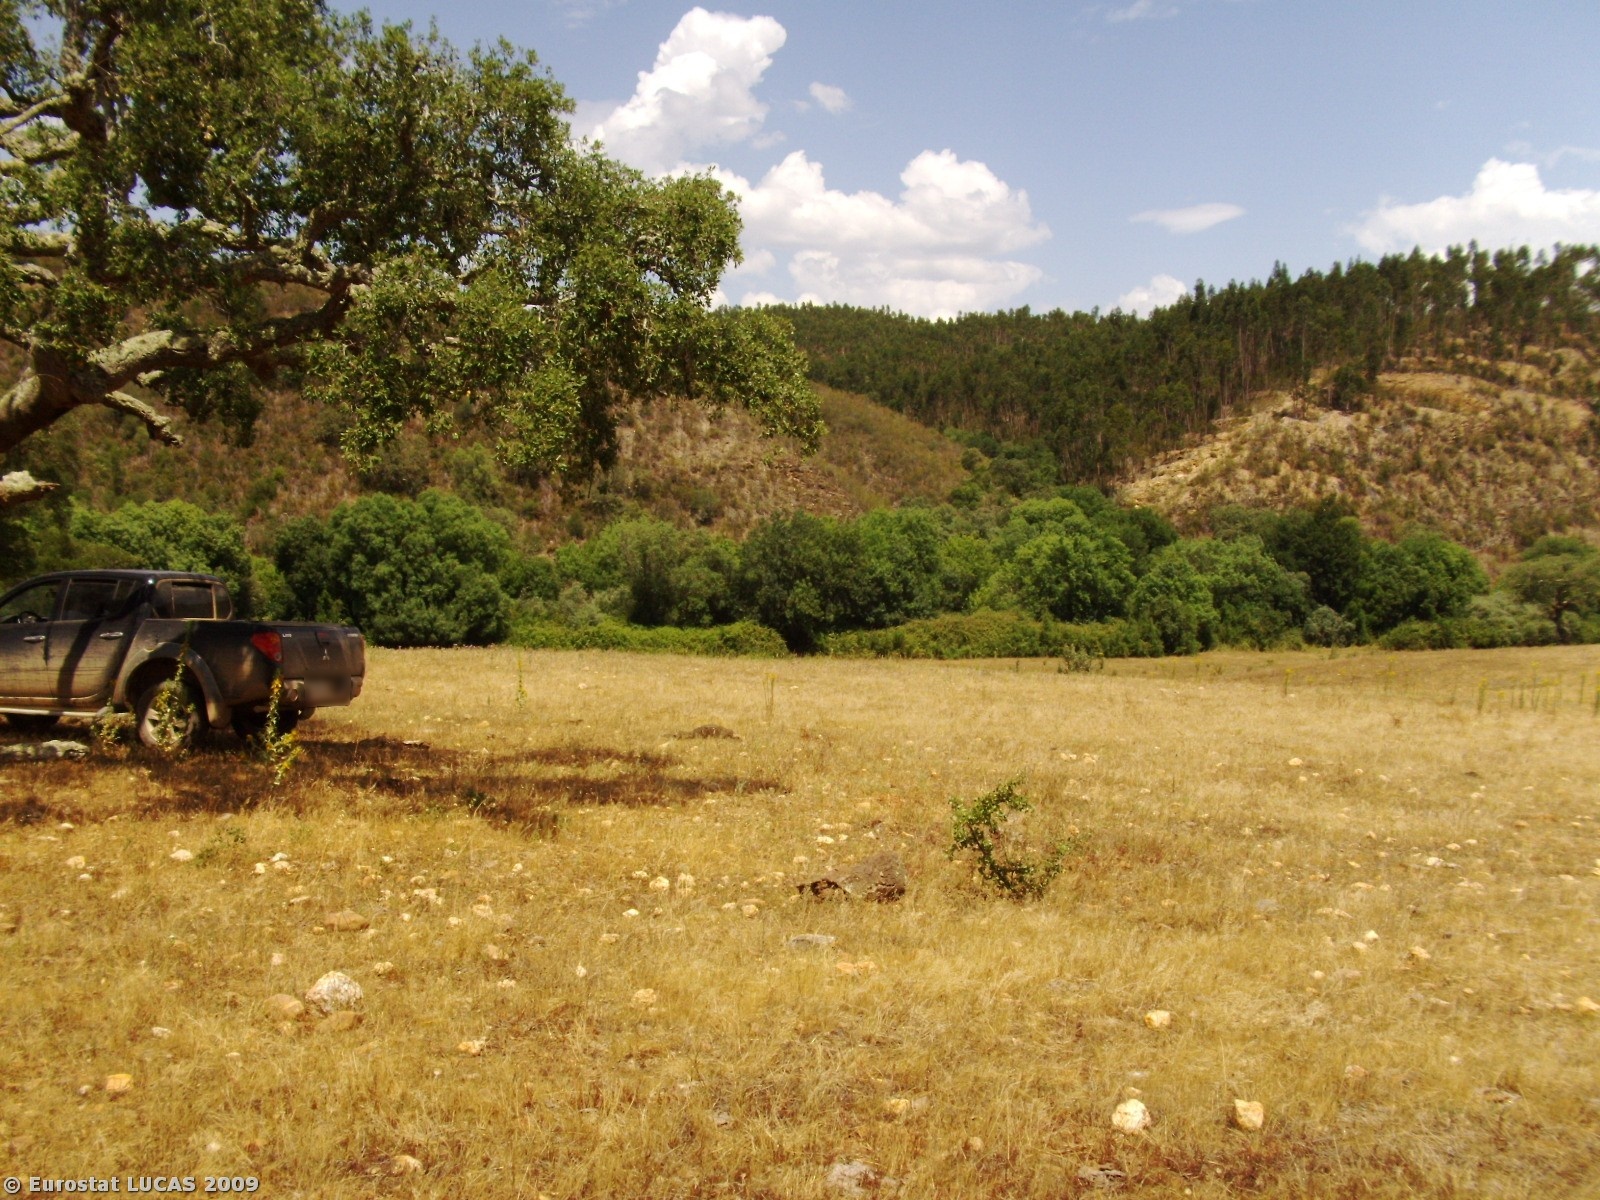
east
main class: Woodland
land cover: Broadleaved woodland
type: broadleaved evergreen forest
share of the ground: 10 - 25 %
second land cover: Spontaneously vegetated surfaces
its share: 50 - 75 %
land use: Forestry
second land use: Fallow land
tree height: > 5 m
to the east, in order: Broadleaved woodland; Spontaneously vegetated surfaces; Shrubland with sparse tree cover; Rivers and streams; Shrubland with sparse tree cover; Inland running water; Shrubland with sparse tree cover; Tracks; Broadleaved woodland
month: June
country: PT
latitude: 37.5167
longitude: -8.5553
